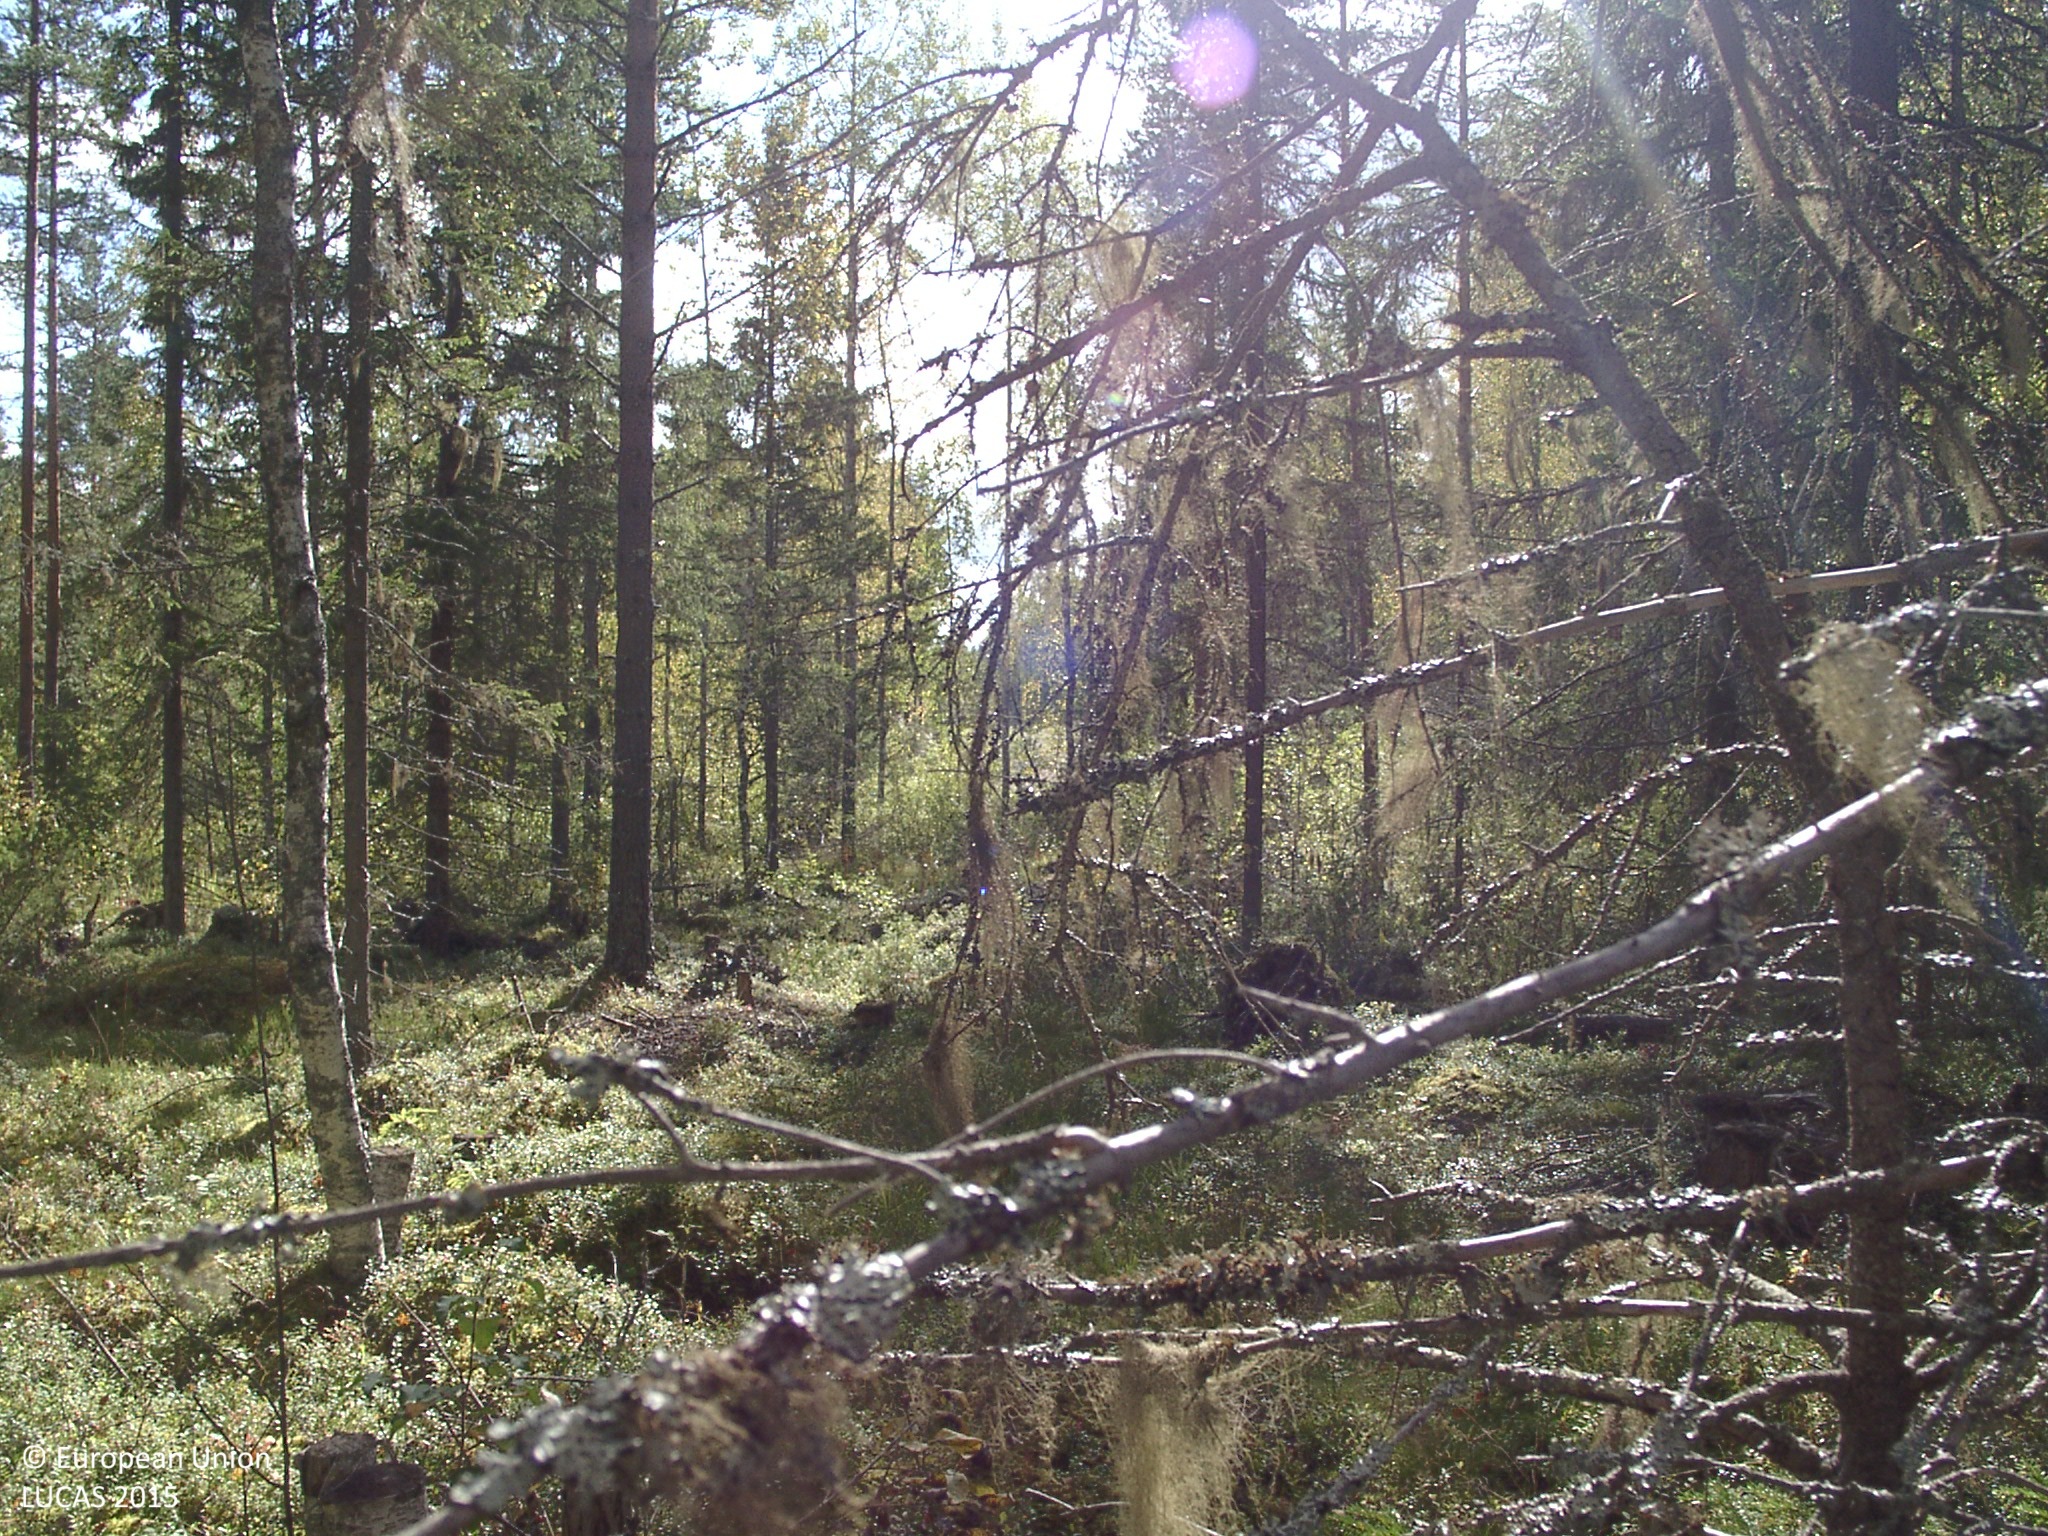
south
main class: Woodland
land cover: Other mixed woodland
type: boreal forest
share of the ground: 50 - 75 %
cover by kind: coniferous forest trees 40 %, shrubs 25 %, broadleaved forest trees 20 %, lichens and mosses 15 %
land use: Forestry
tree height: > 5 m
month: September
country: FI
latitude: 62.8741
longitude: 25.6622
